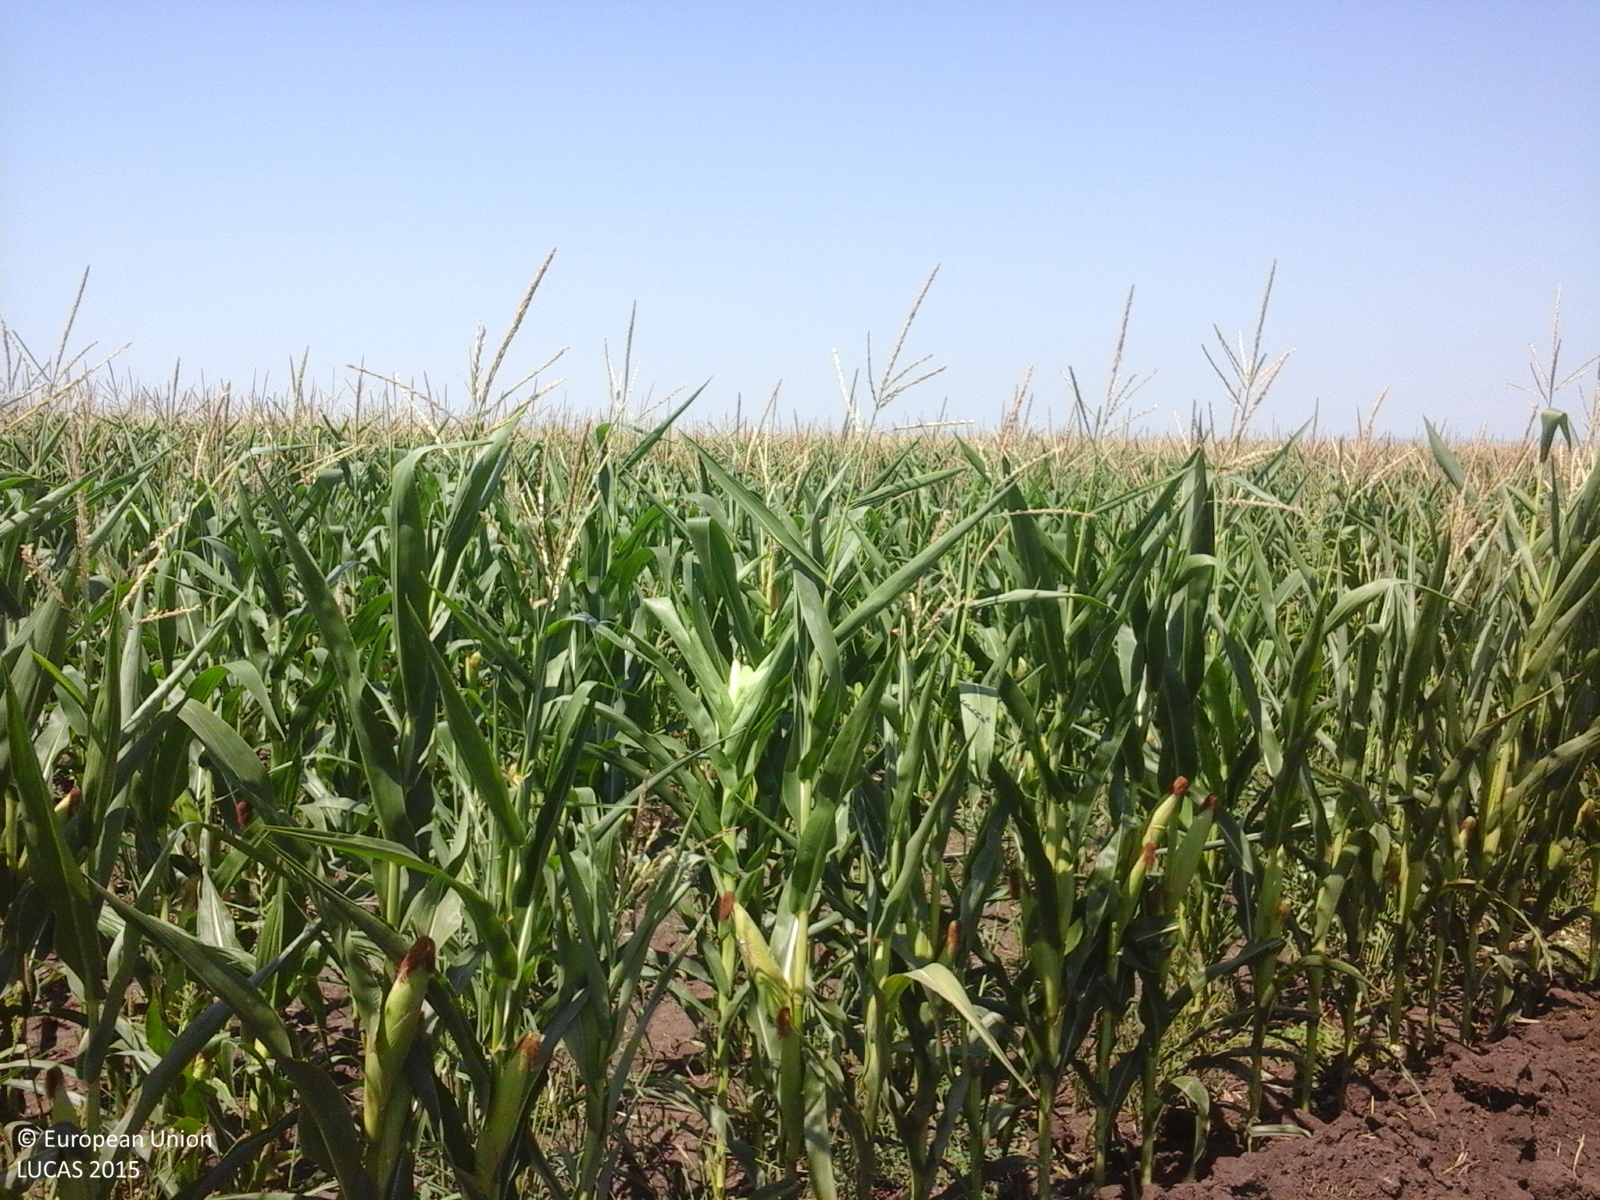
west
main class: Cropland
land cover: Maize
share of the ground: > 75 %
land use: Agriculture (excluding fallow land and kitchen gardens)
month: July
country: RO
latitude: 44.9740
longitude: 26.5684
